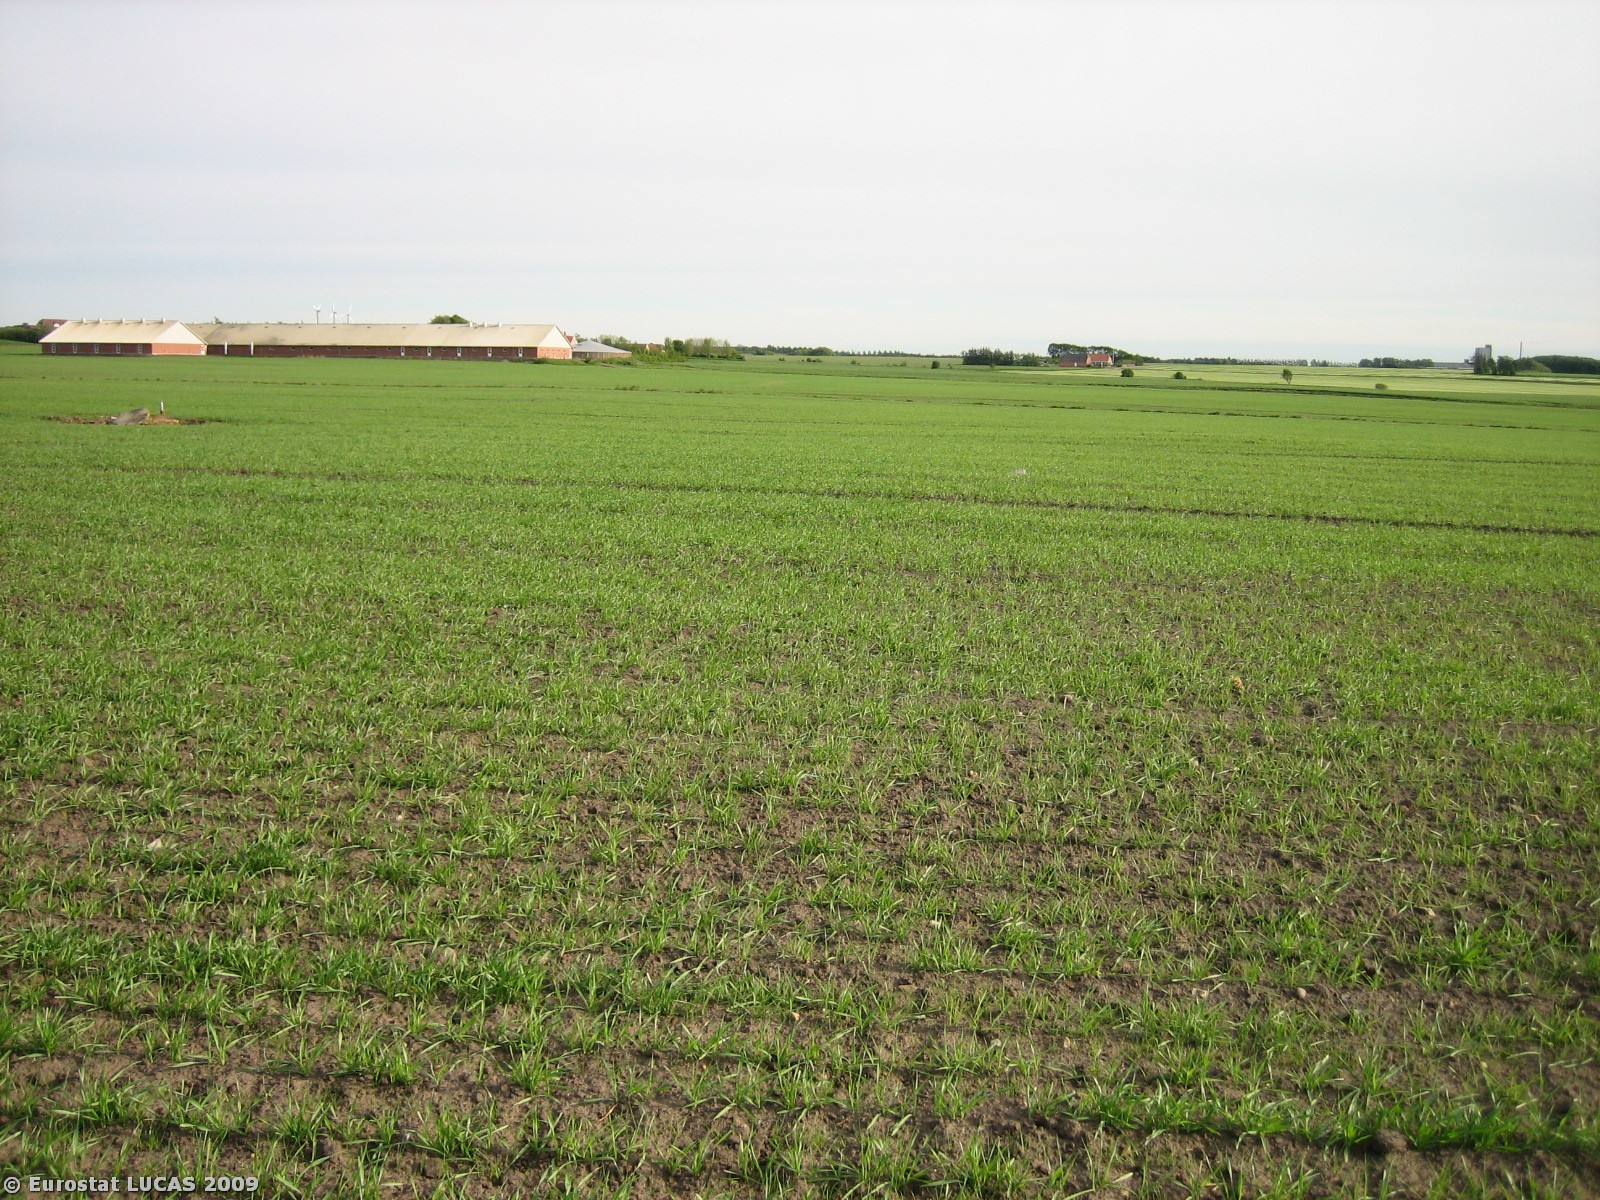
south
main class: Cropland
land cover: Barley
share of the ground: 25 - 50 %
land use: Agriculture (excluding fallow land and kitchen gardens)
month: May
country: DK
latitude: 56.1060
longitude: 8.4099
